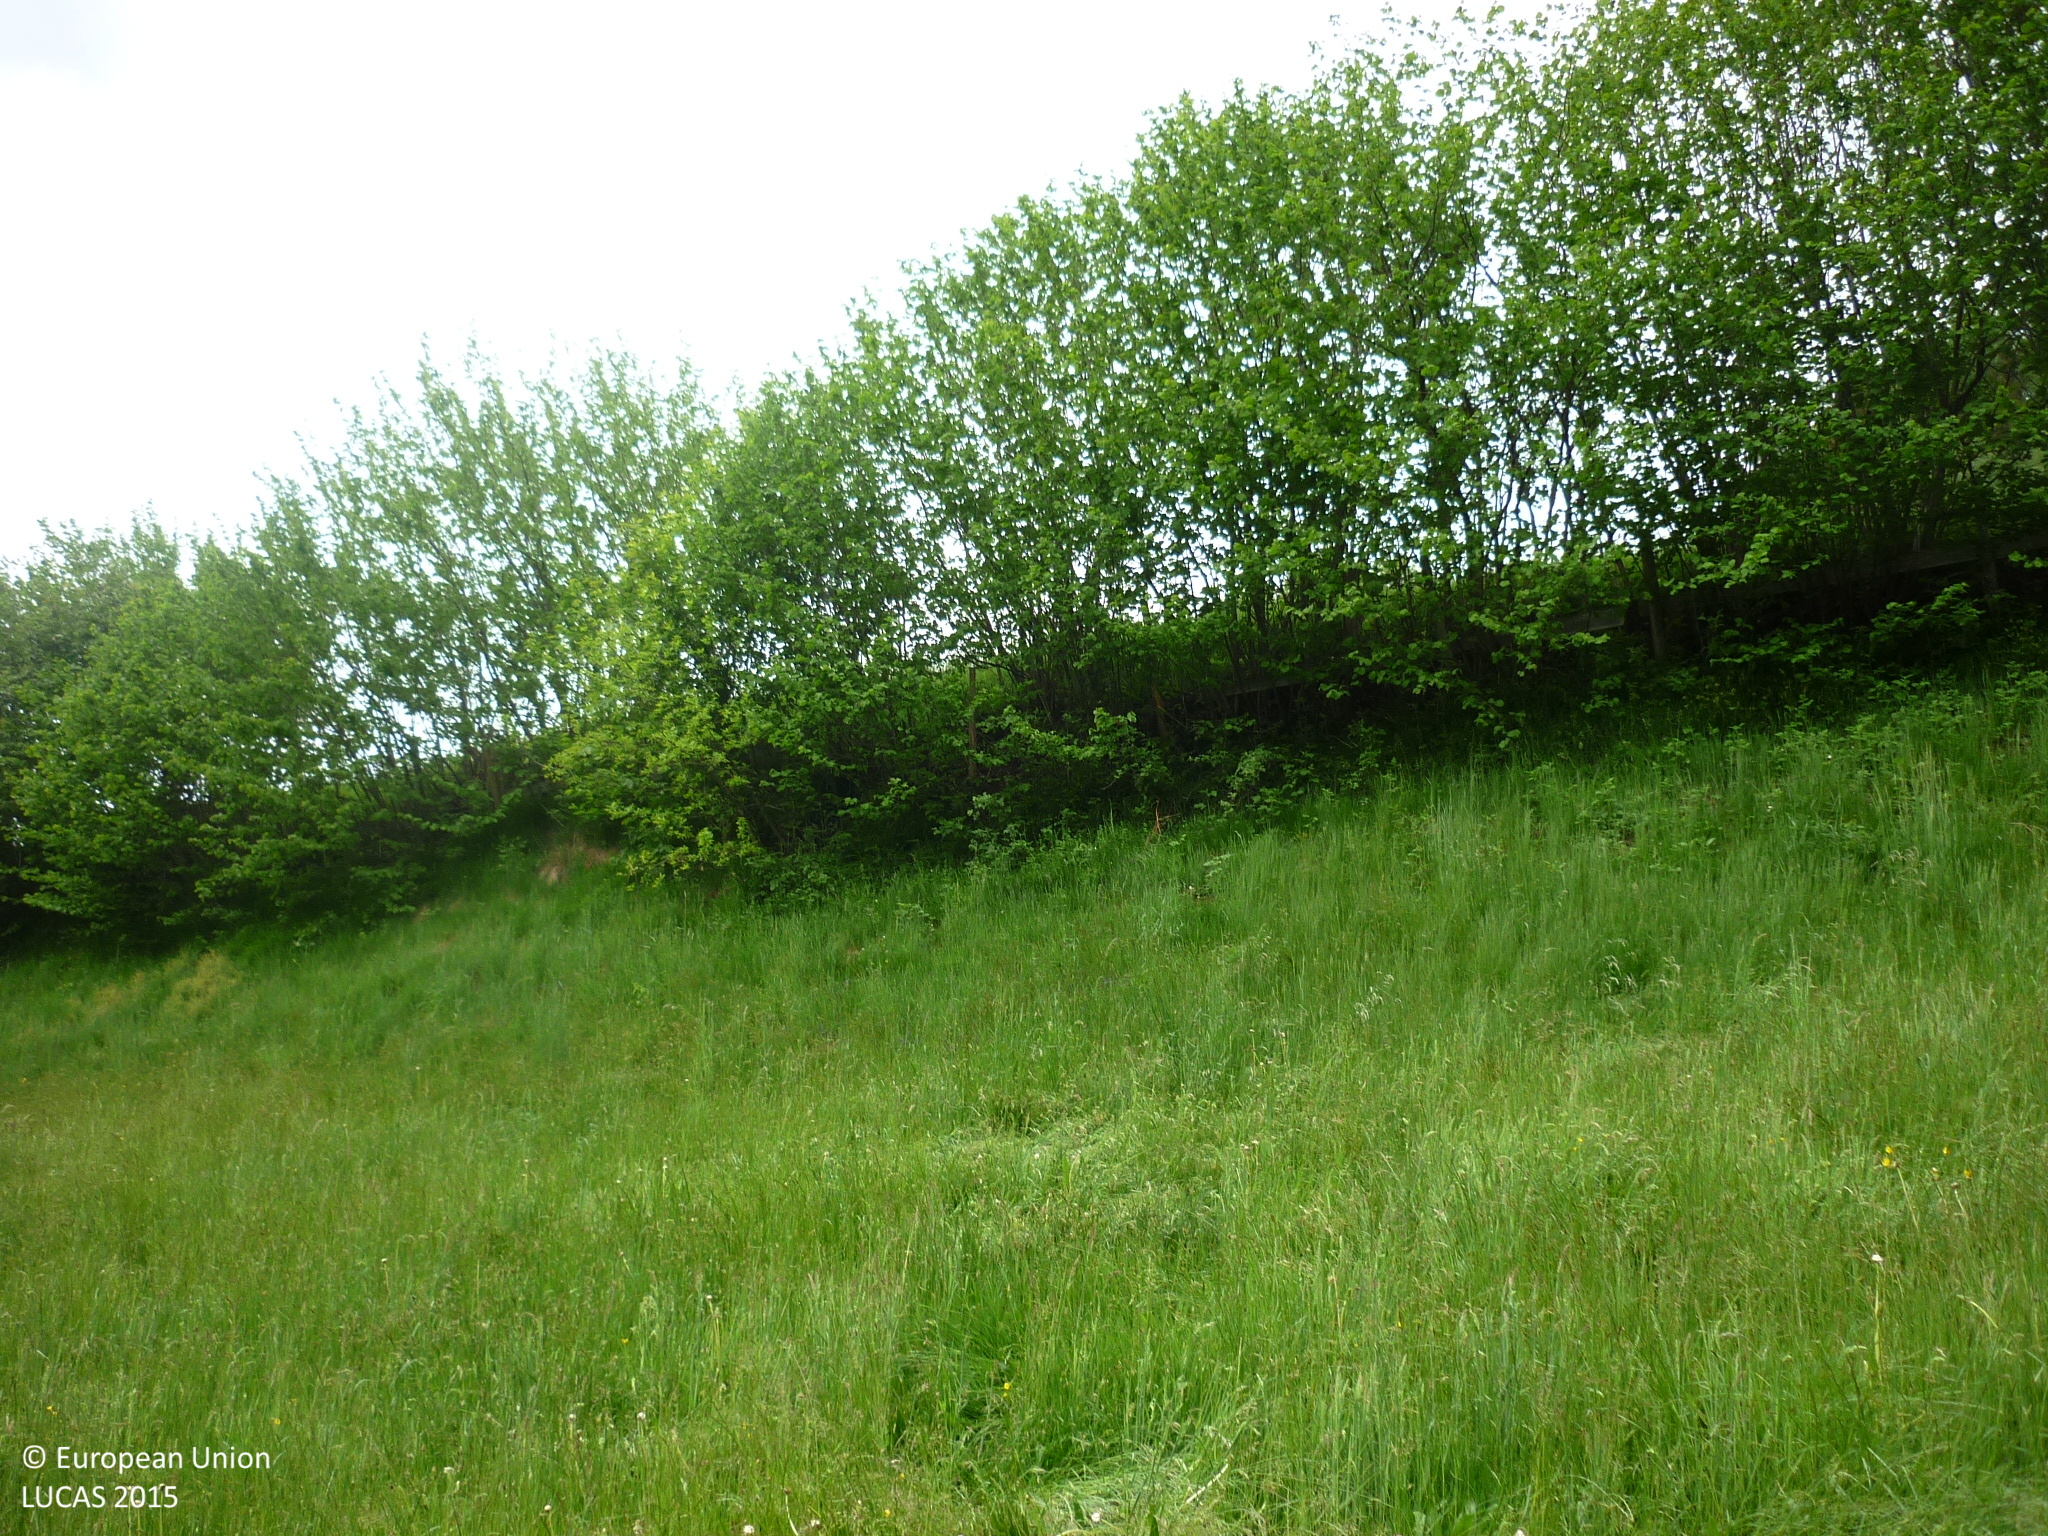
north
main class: Grassland
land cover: Grassland without tree/shrub cover
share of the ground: > 75 %
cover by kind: herbaceous plants 100 %
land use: Agriculture (excluding fallow land and kitchen gardens)
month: May
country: AT
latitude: 47.4796
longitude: 14.1258
